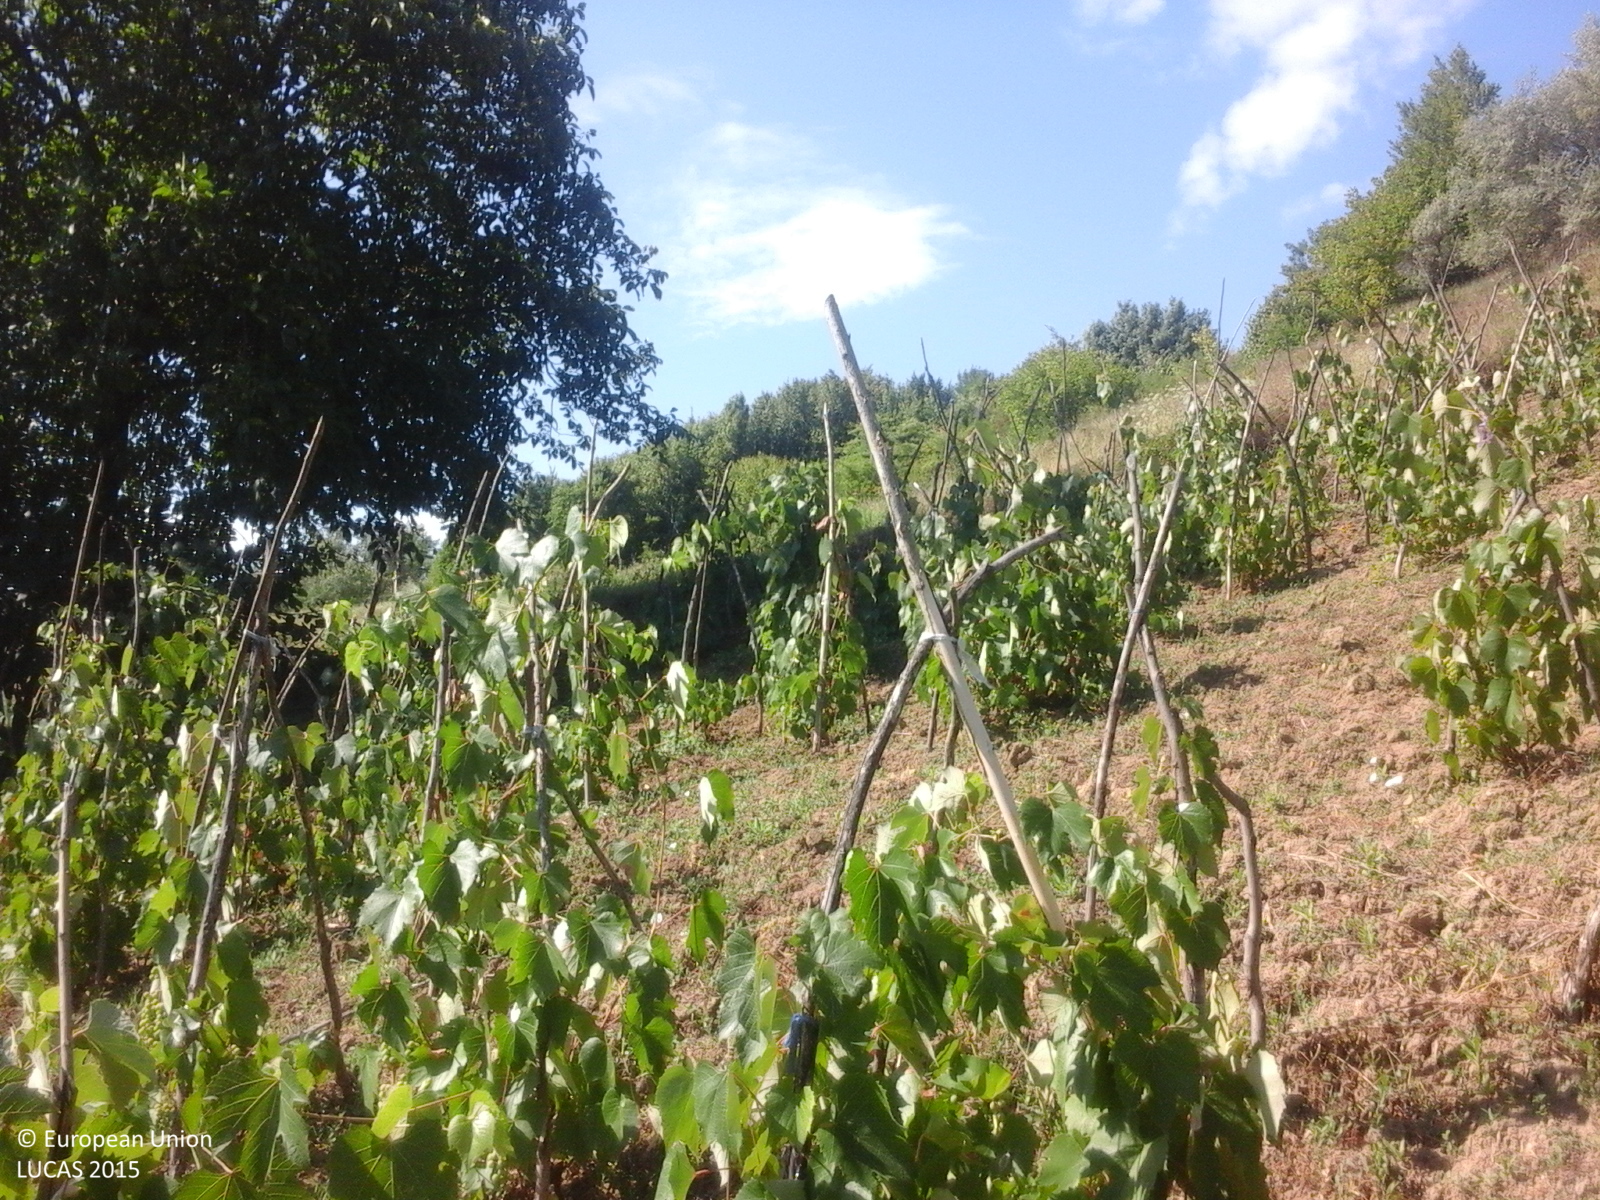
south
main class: Cropland
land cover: Vineyards
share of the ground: > 75 %
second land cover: Other bare soil
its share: > 75 %
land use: Agriculture (excluding fallow land and kitchen gardens)
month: July
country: RO
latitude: 46.4373
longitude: 27.2973
